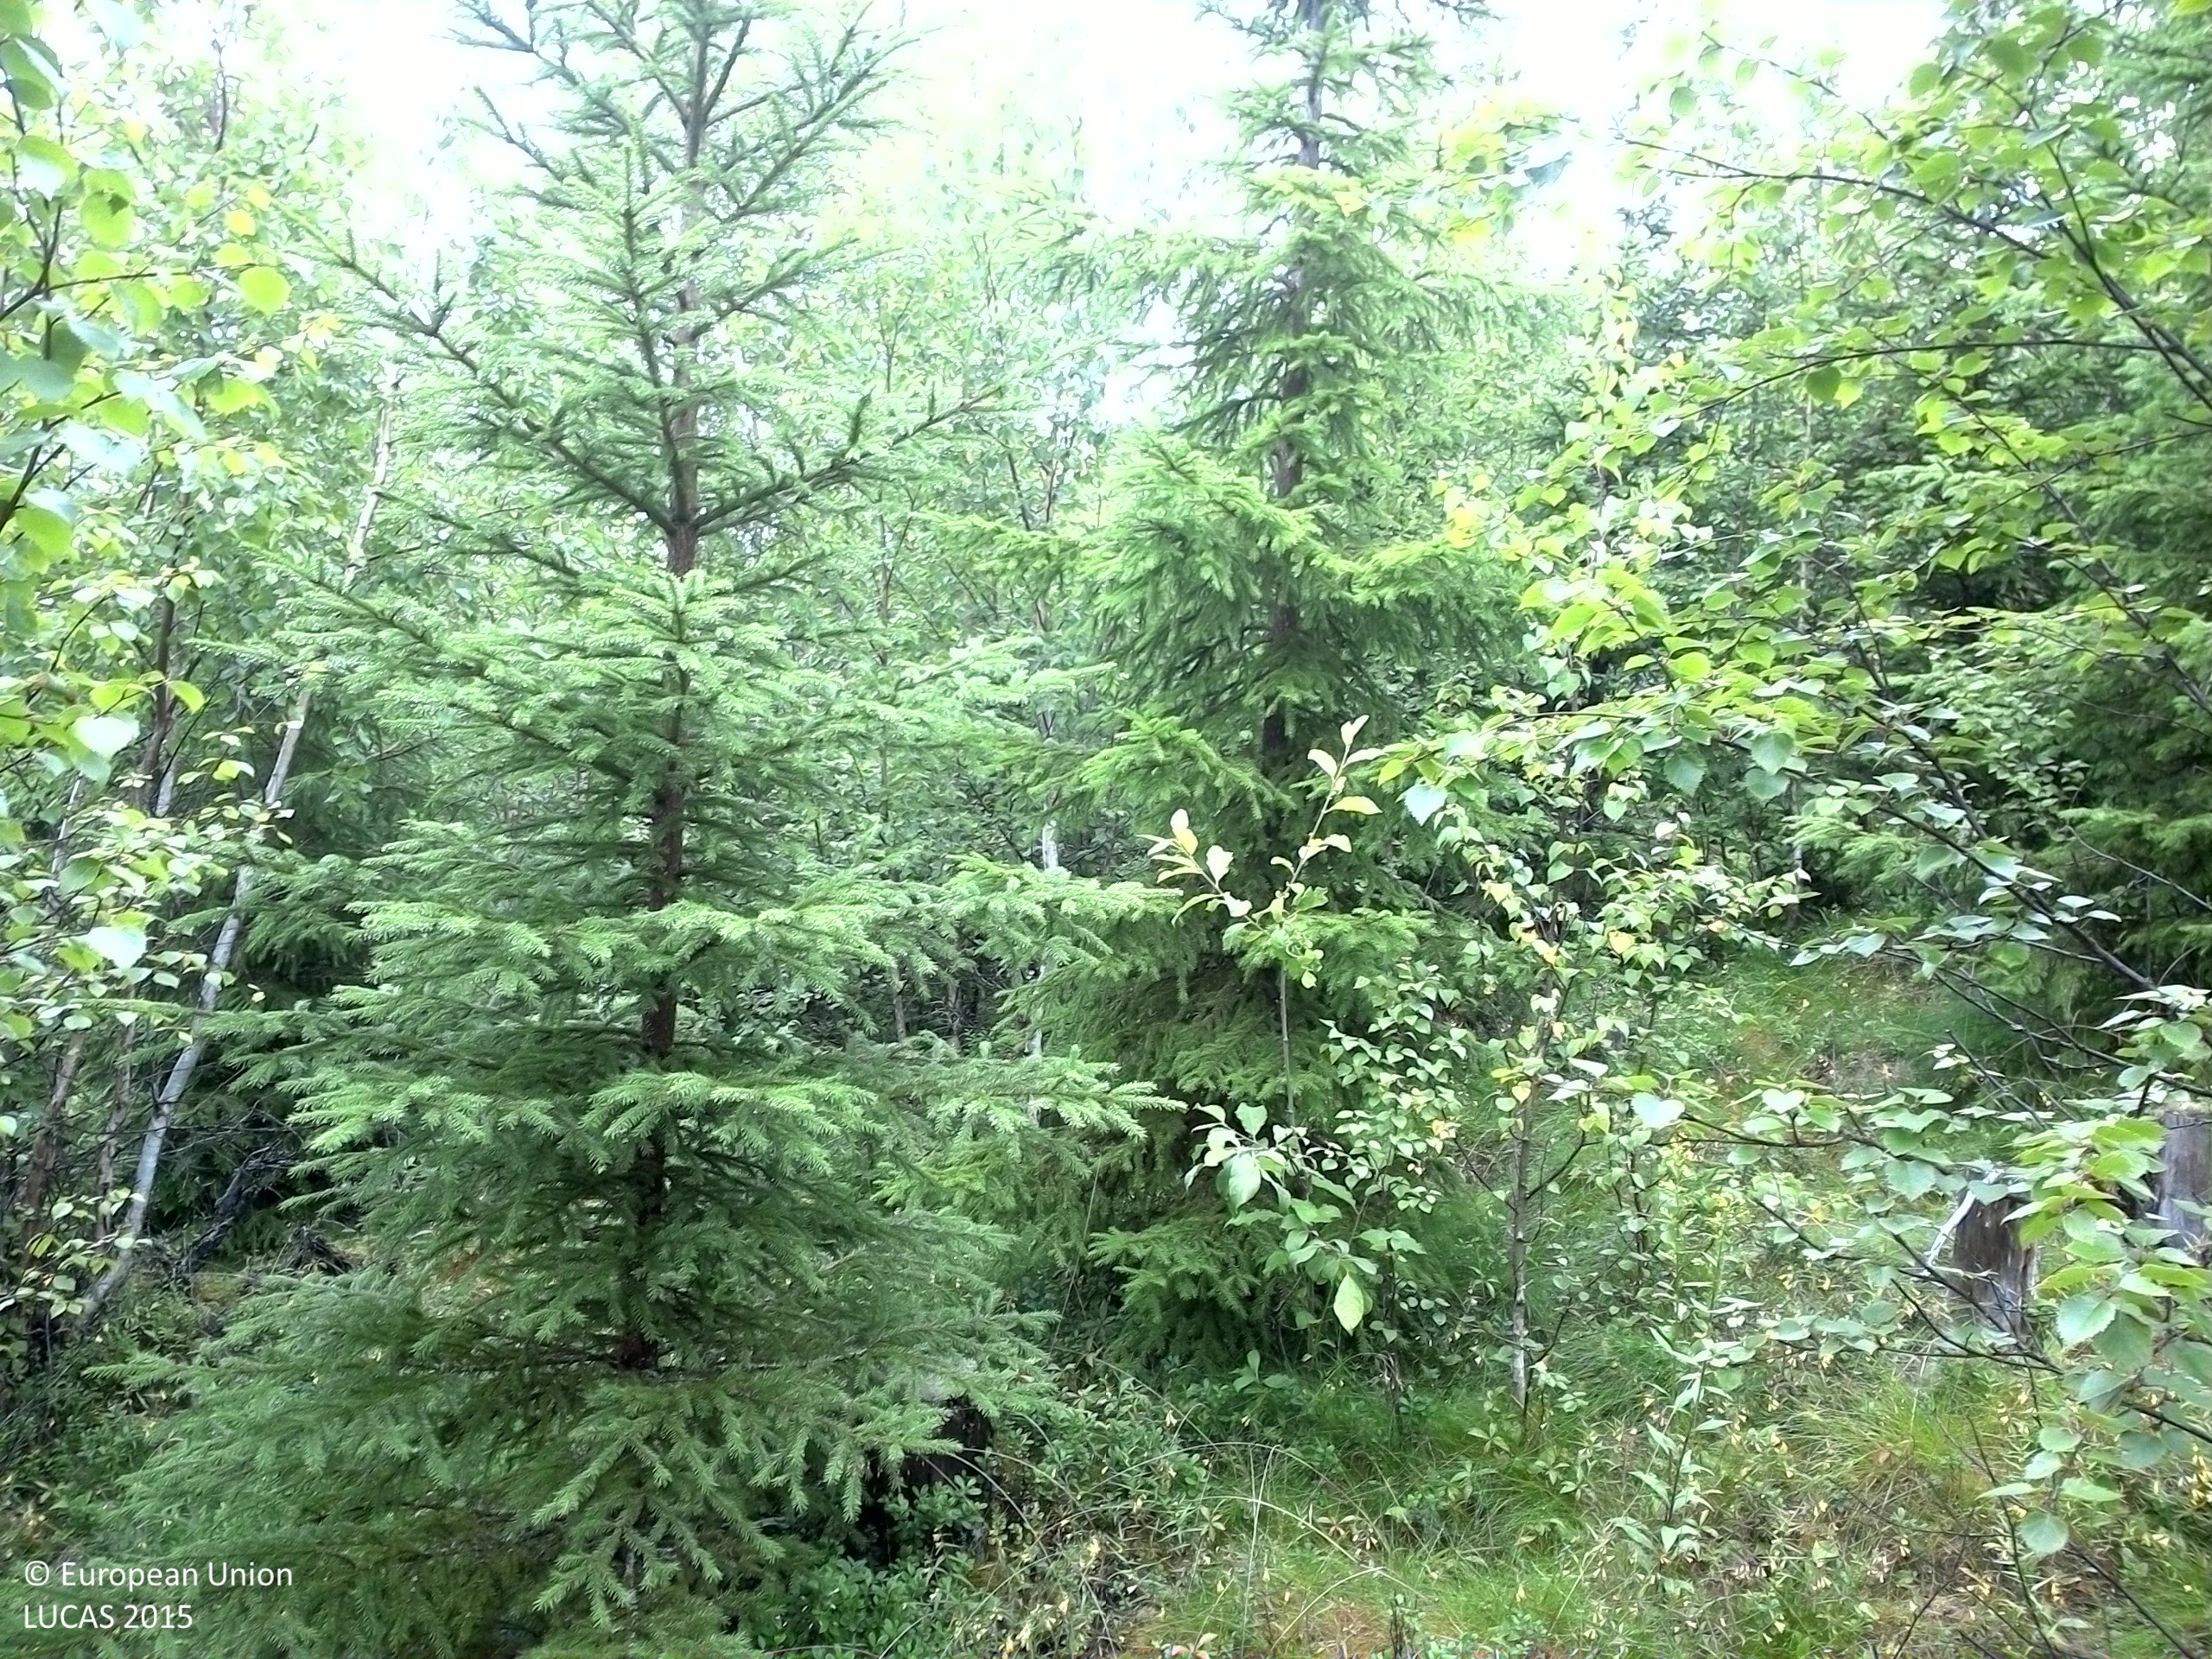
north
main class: Woodland
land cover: Spruce dominated mixed woodland
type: boreal forest
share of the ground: > 75 %
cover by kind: coniferous forest trees 45 %, broadleaved forest trees 35 %, herbaceous plants 15 %, shrubs 5 %
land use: Forestry
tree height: < 5 m
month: July
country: SE
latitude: 62.6566
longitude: 17.2188
